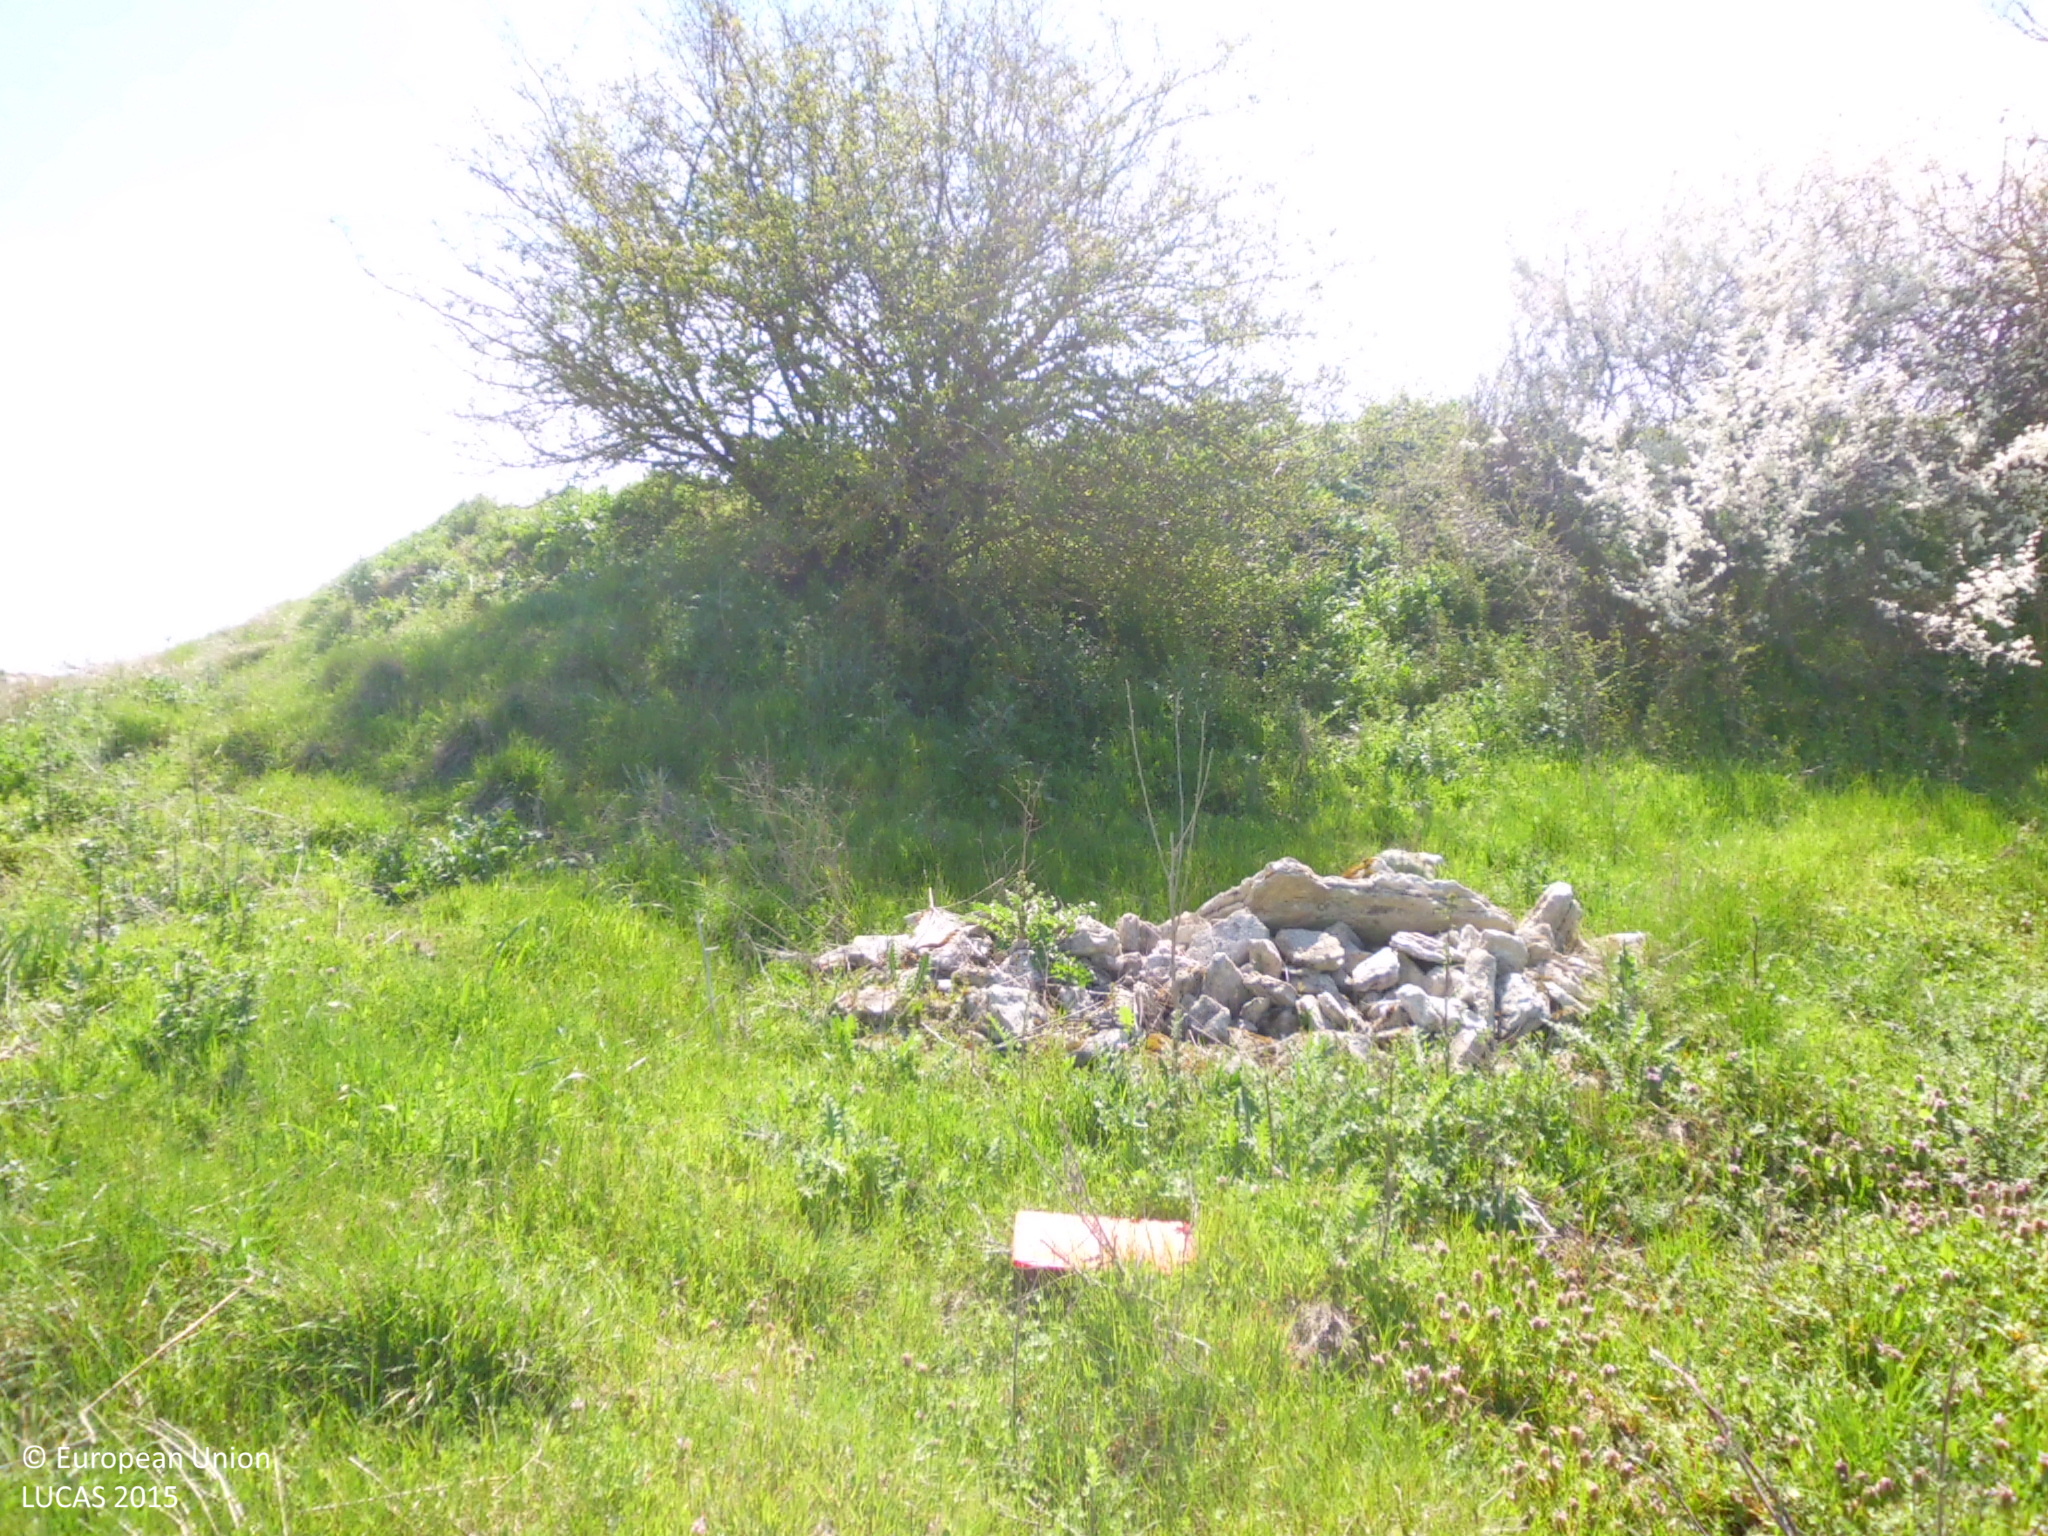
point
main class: Grassland
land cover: Grassland with sparse tree/shrub cover
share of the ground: > 75 %
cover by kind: herbaceous plants 90 %, broadleaved forest trees 5 %, shrubs 5 %
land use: Abandoned areas
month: April
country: ES
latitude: 42.4639
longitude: -3.3245
